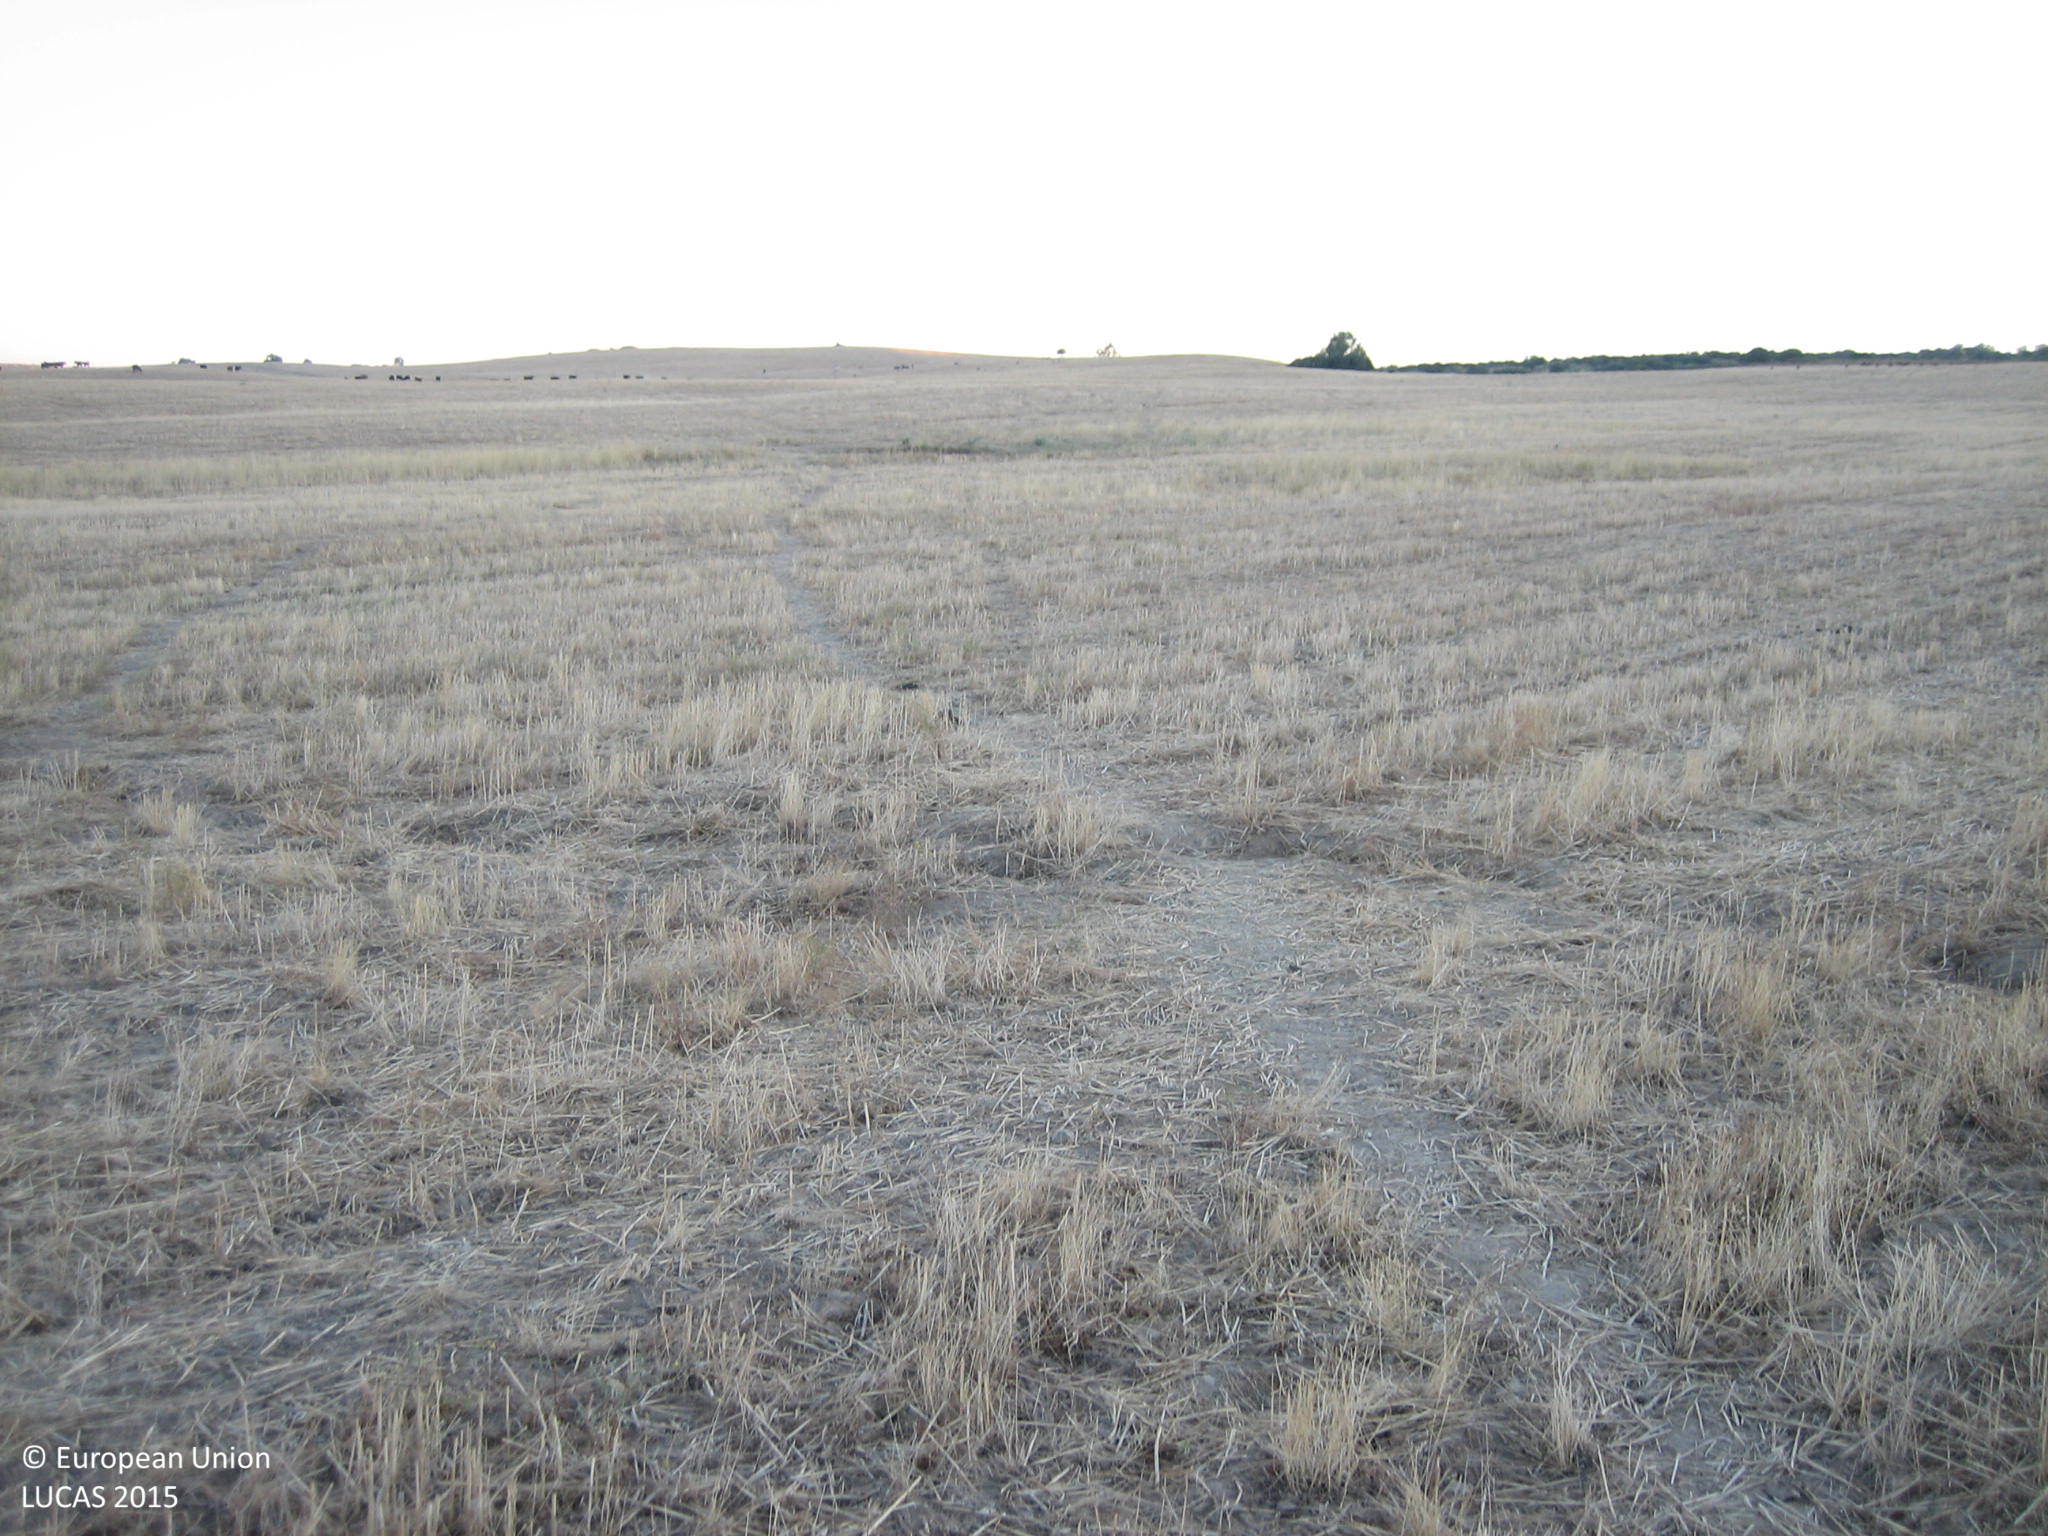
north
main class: Cropland
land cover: Common wheat
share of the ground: < 10 %
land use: Agriculture (excluding fallow land and kitchen gardens)
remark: Harvested field
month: July
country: ES
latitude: 38.2649
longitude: -6.0997
